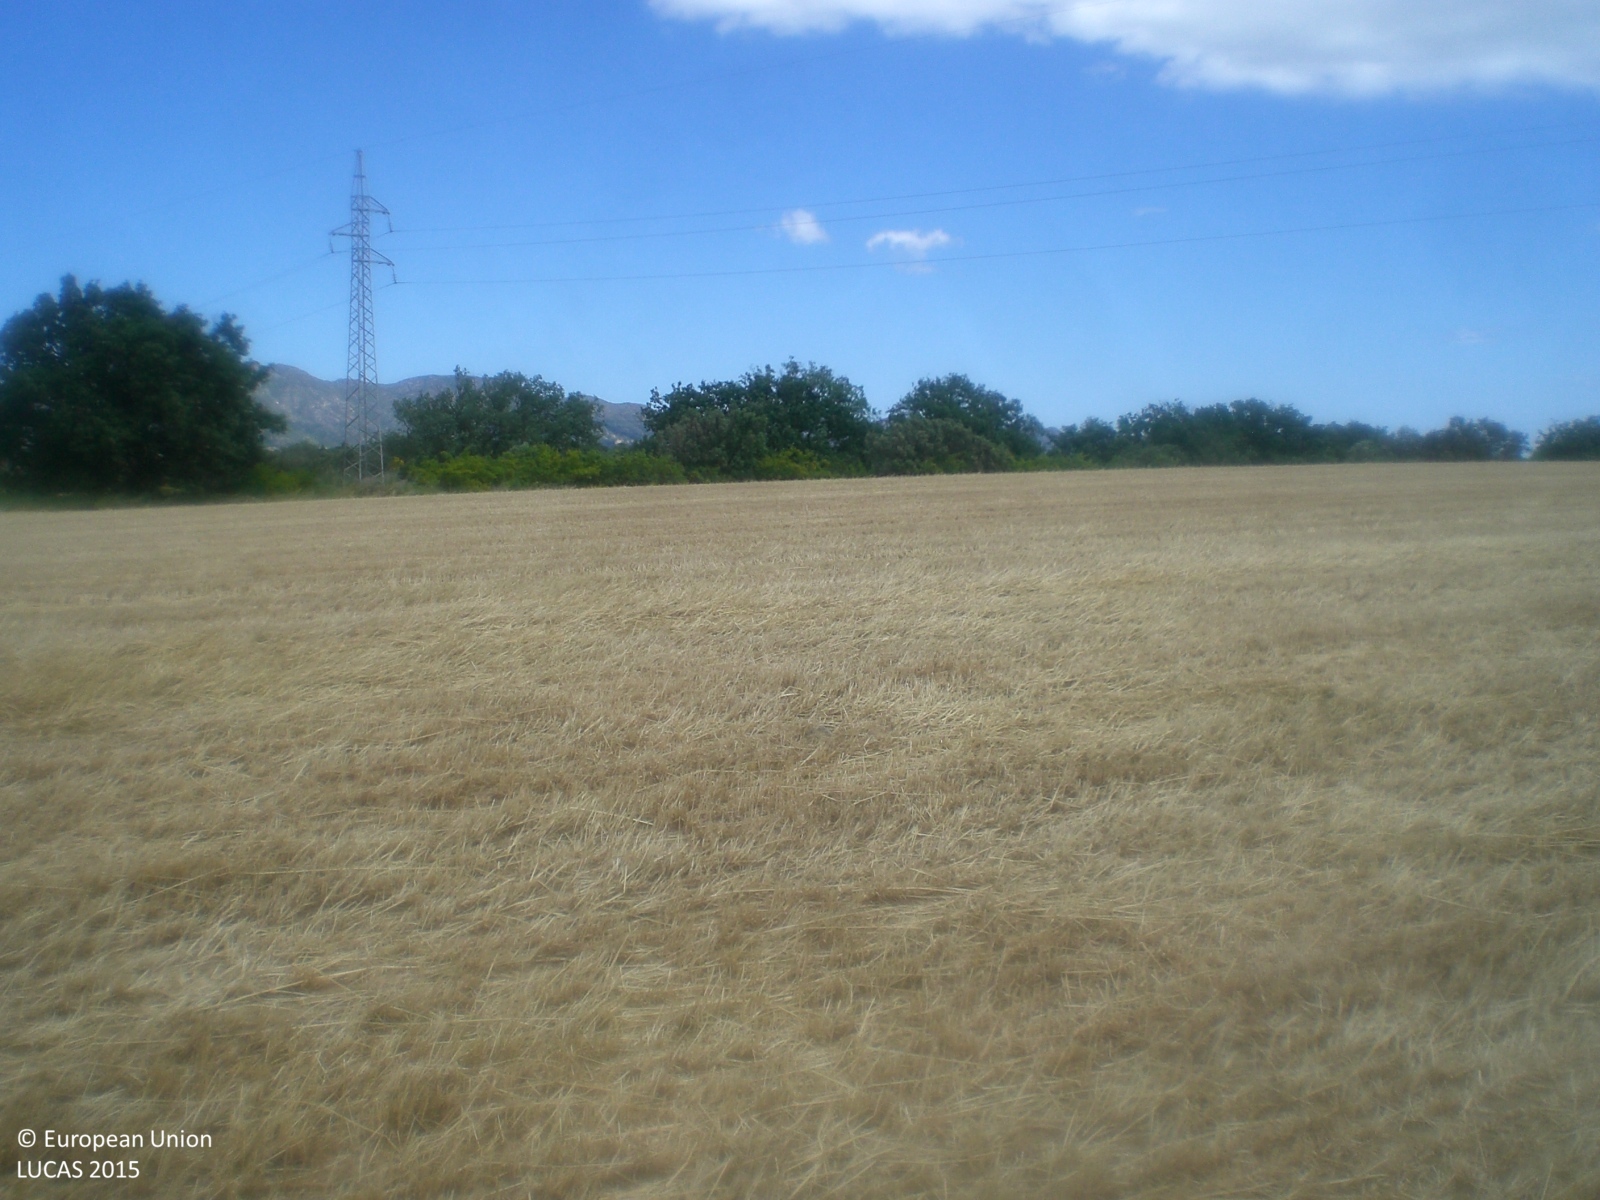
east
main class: Cropland
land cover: Oats
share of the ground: < 10 %
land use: Agriculture (excluding fallow land and kitchen gardens)
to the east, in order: Oats; Electric lines; Grass margins; Shruby margins; Shrubland with sparse tree cover; Broadleaved woodland; Shrubland without tree cover; Abandoned hedges; Grass margins; Barley; Abandoned hedges; Grass margins; Paved roads, cycling and walking lanes; Grass margins; Abandoned hedges
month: May
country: ES
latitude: 42.3056
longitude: 3.0388
